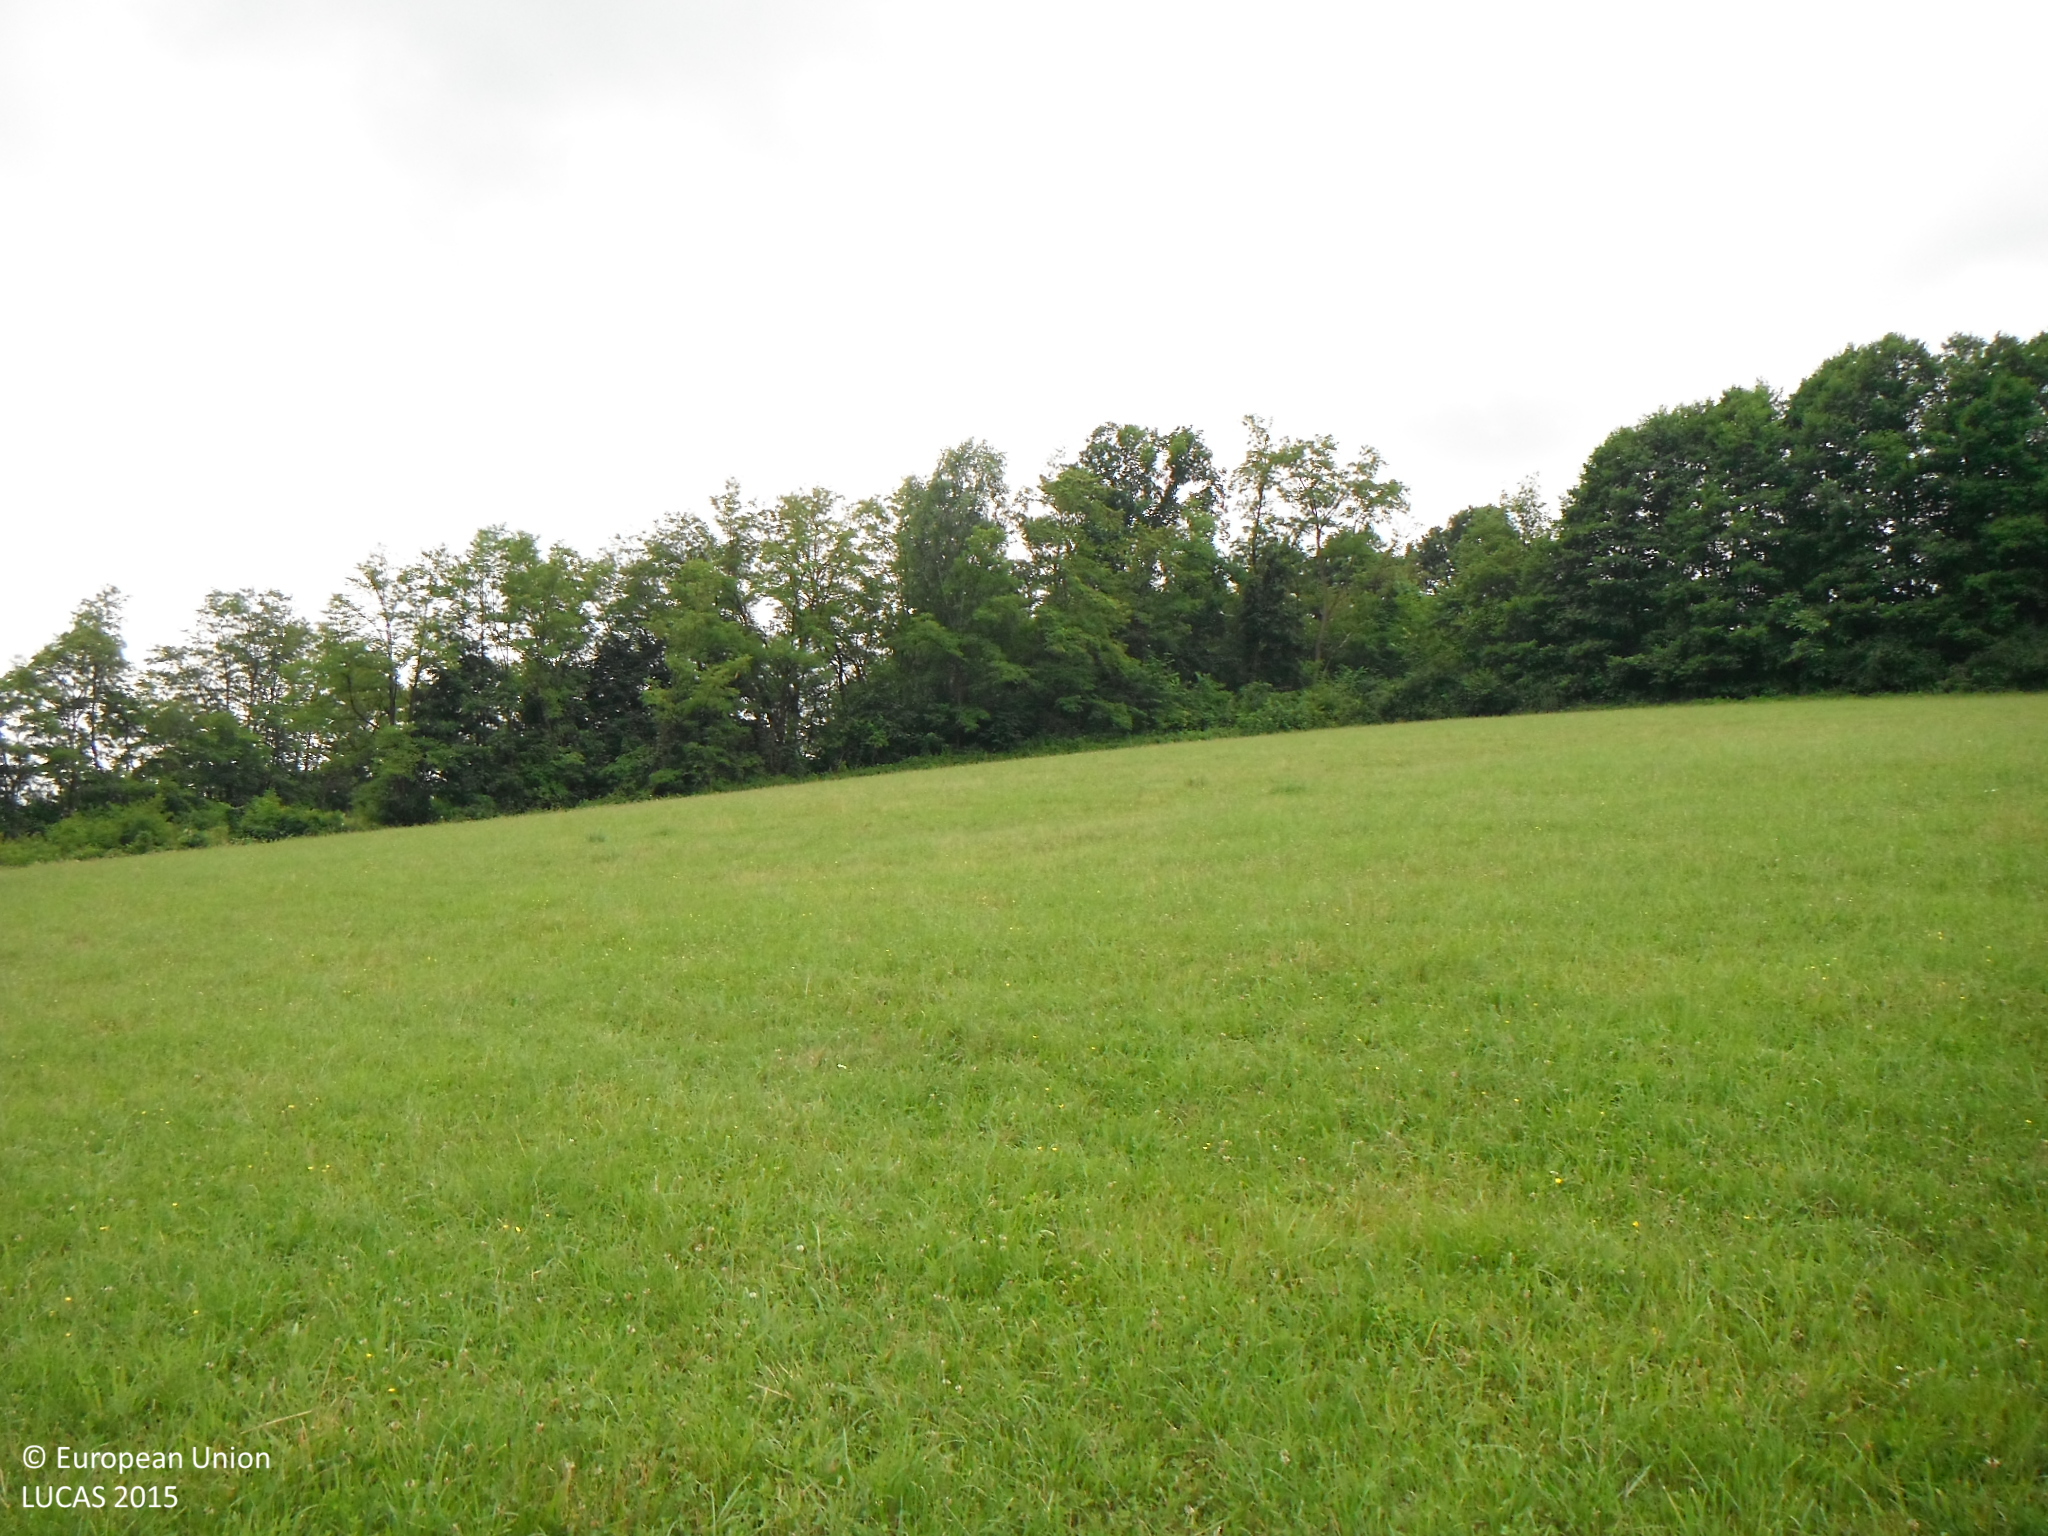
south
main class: Grassland
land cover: Grassland without tree/shrub cover
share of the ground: > 75 %
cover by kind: herbaceous plants 100 %
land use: Agriculture (excluding fallow land and kitchen gardens)
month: June
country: SK
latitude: 48.5890
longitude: 19.9397
